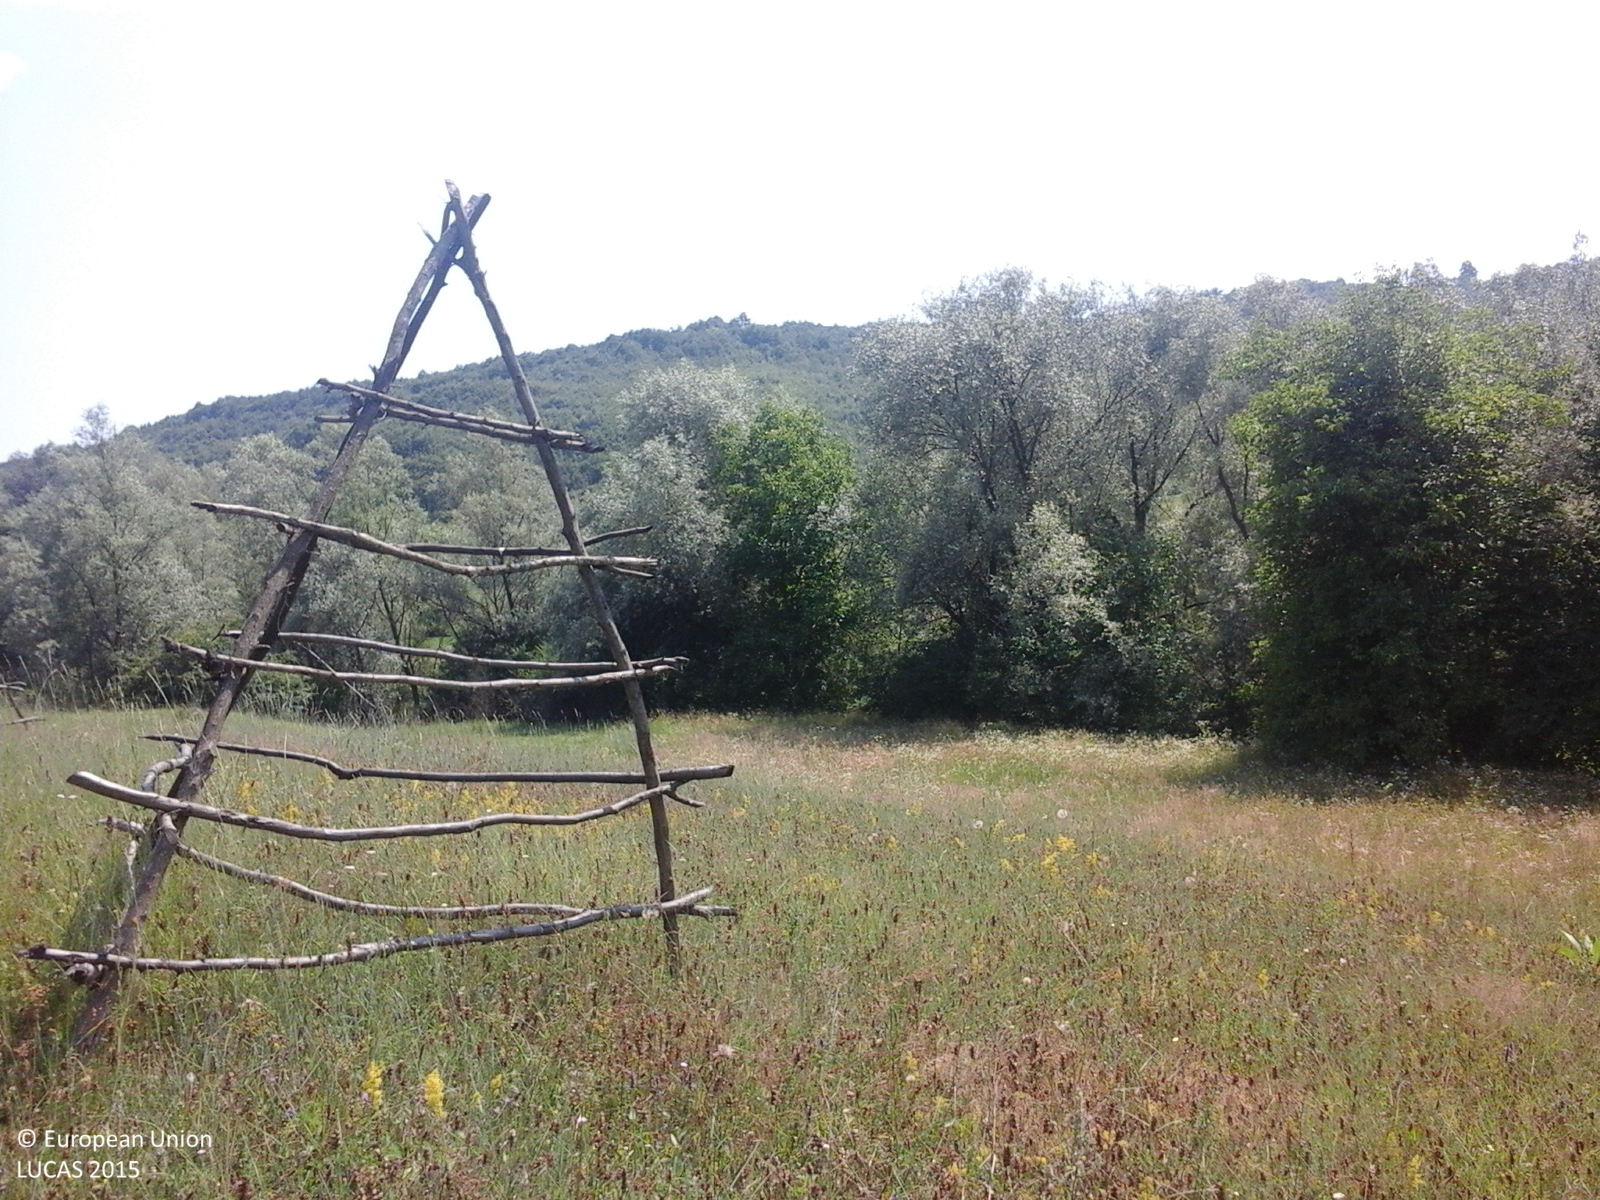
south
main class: Grassland
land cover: Grassland without tree/shrub cover
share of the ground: > 75 %
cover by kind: herbaceous plants 100 %
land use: Agriculture (excluding fallow land and kitchen gardens)
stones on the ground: < 10 %
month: July
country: RO
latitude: 45.1572
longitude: 24.6188
